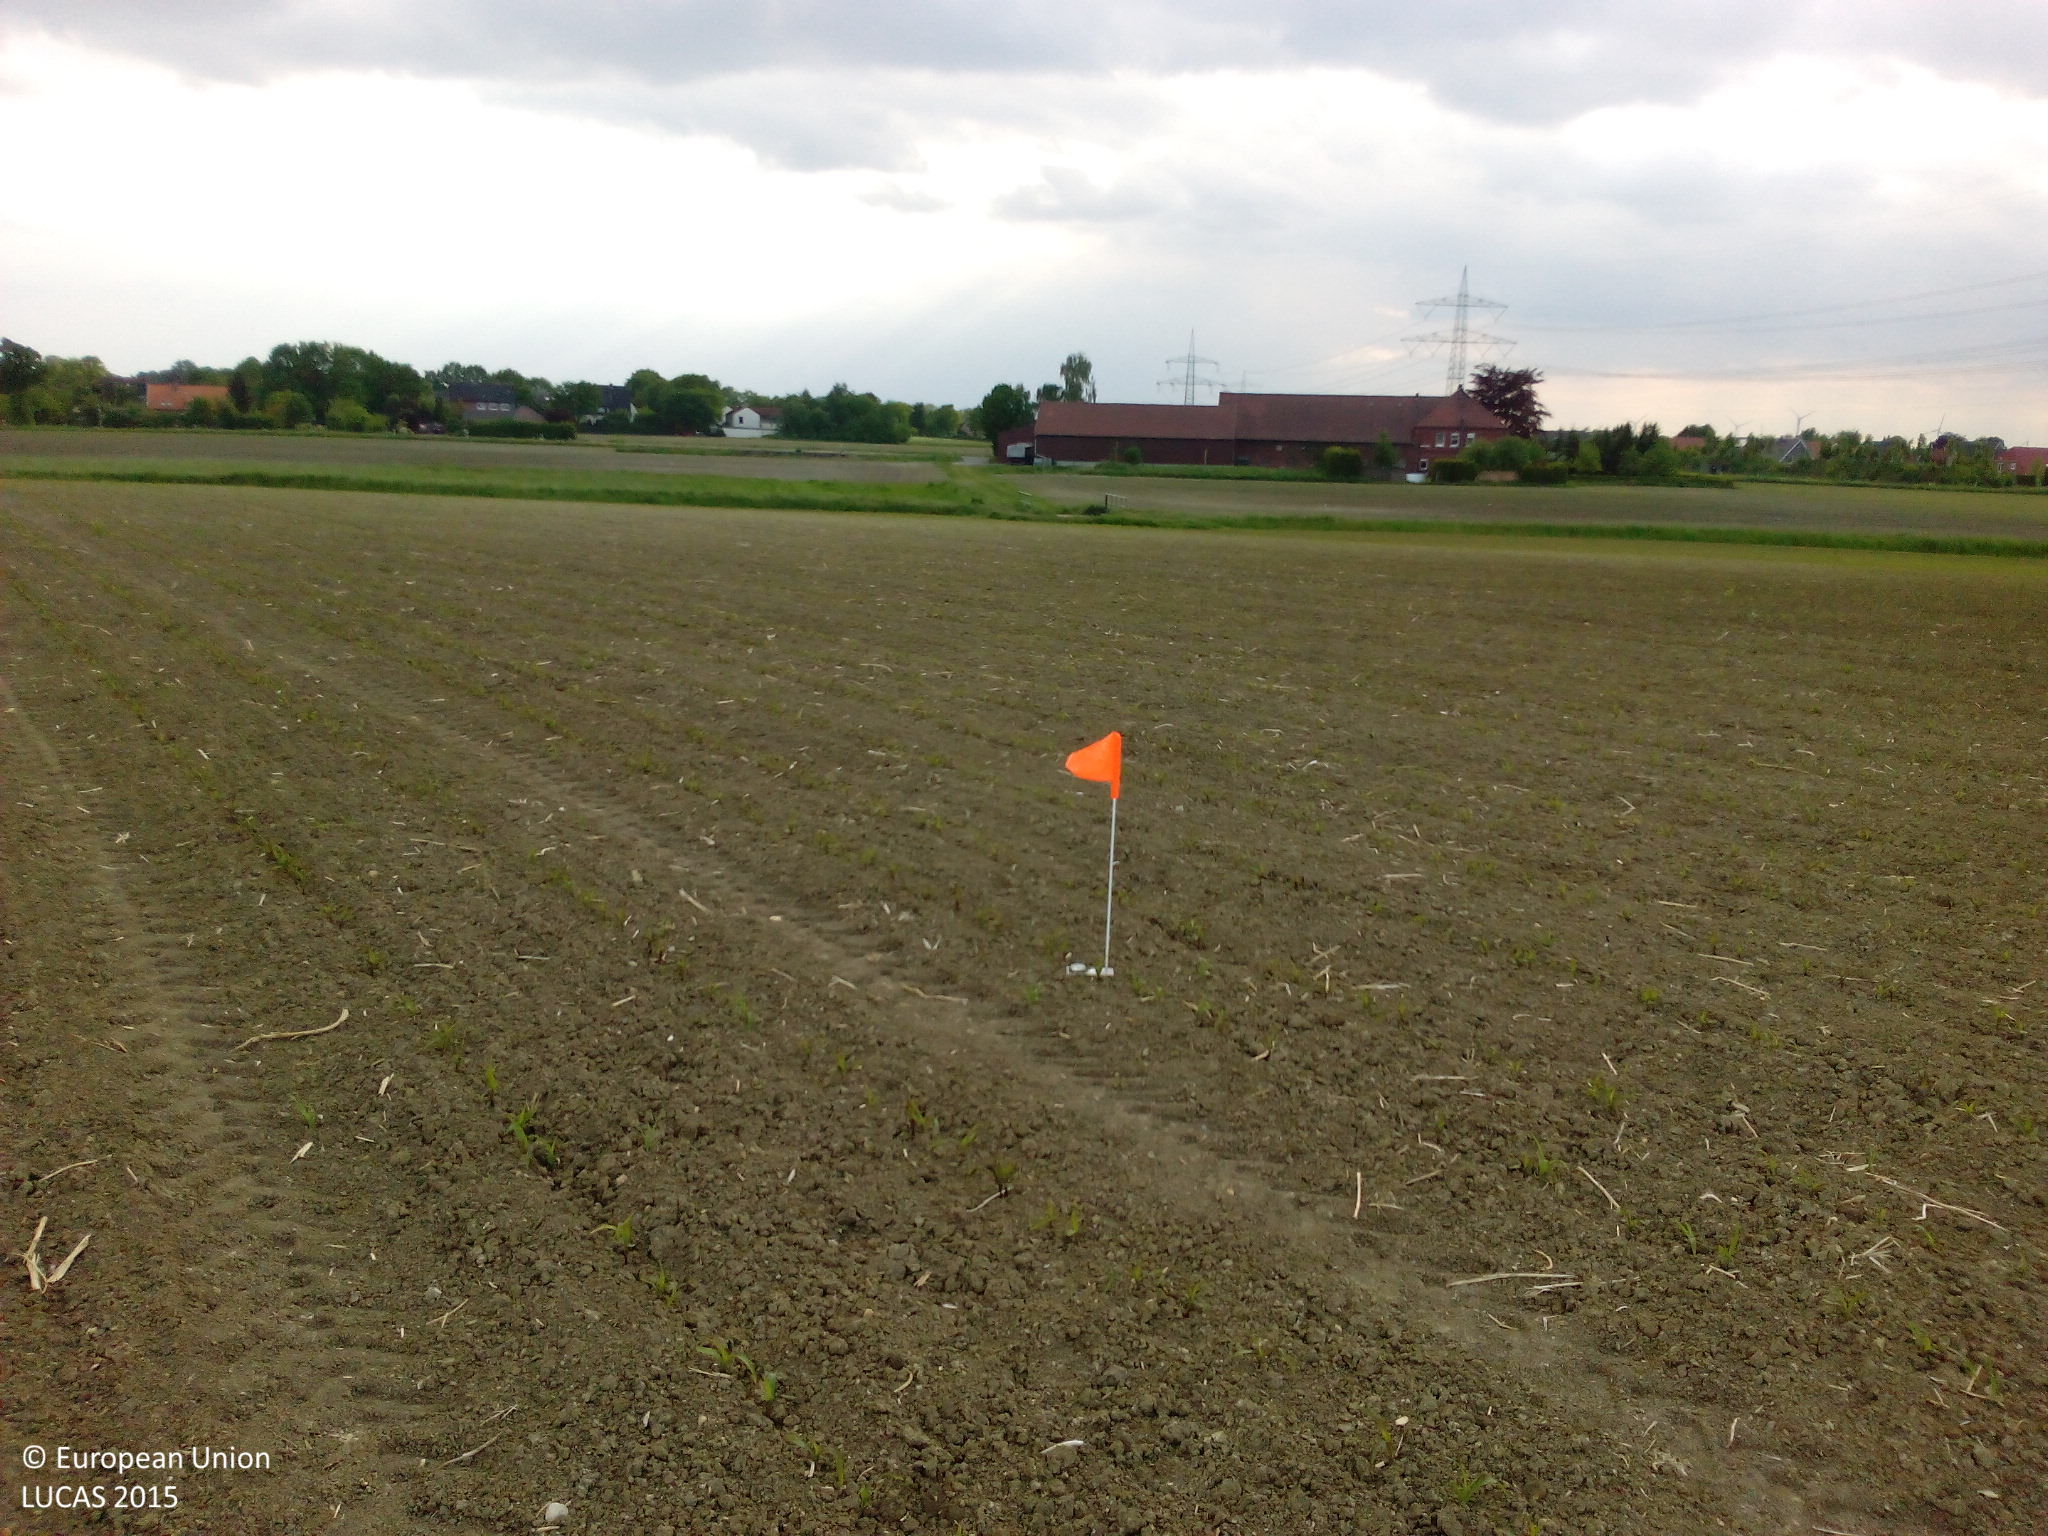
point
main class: Cropland
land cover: Maize
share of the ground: < 10 %
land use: Agriculture (excluding fallow land and kitchen gardens)
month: May
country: DE
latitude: 51.8025
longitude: 7.9556
